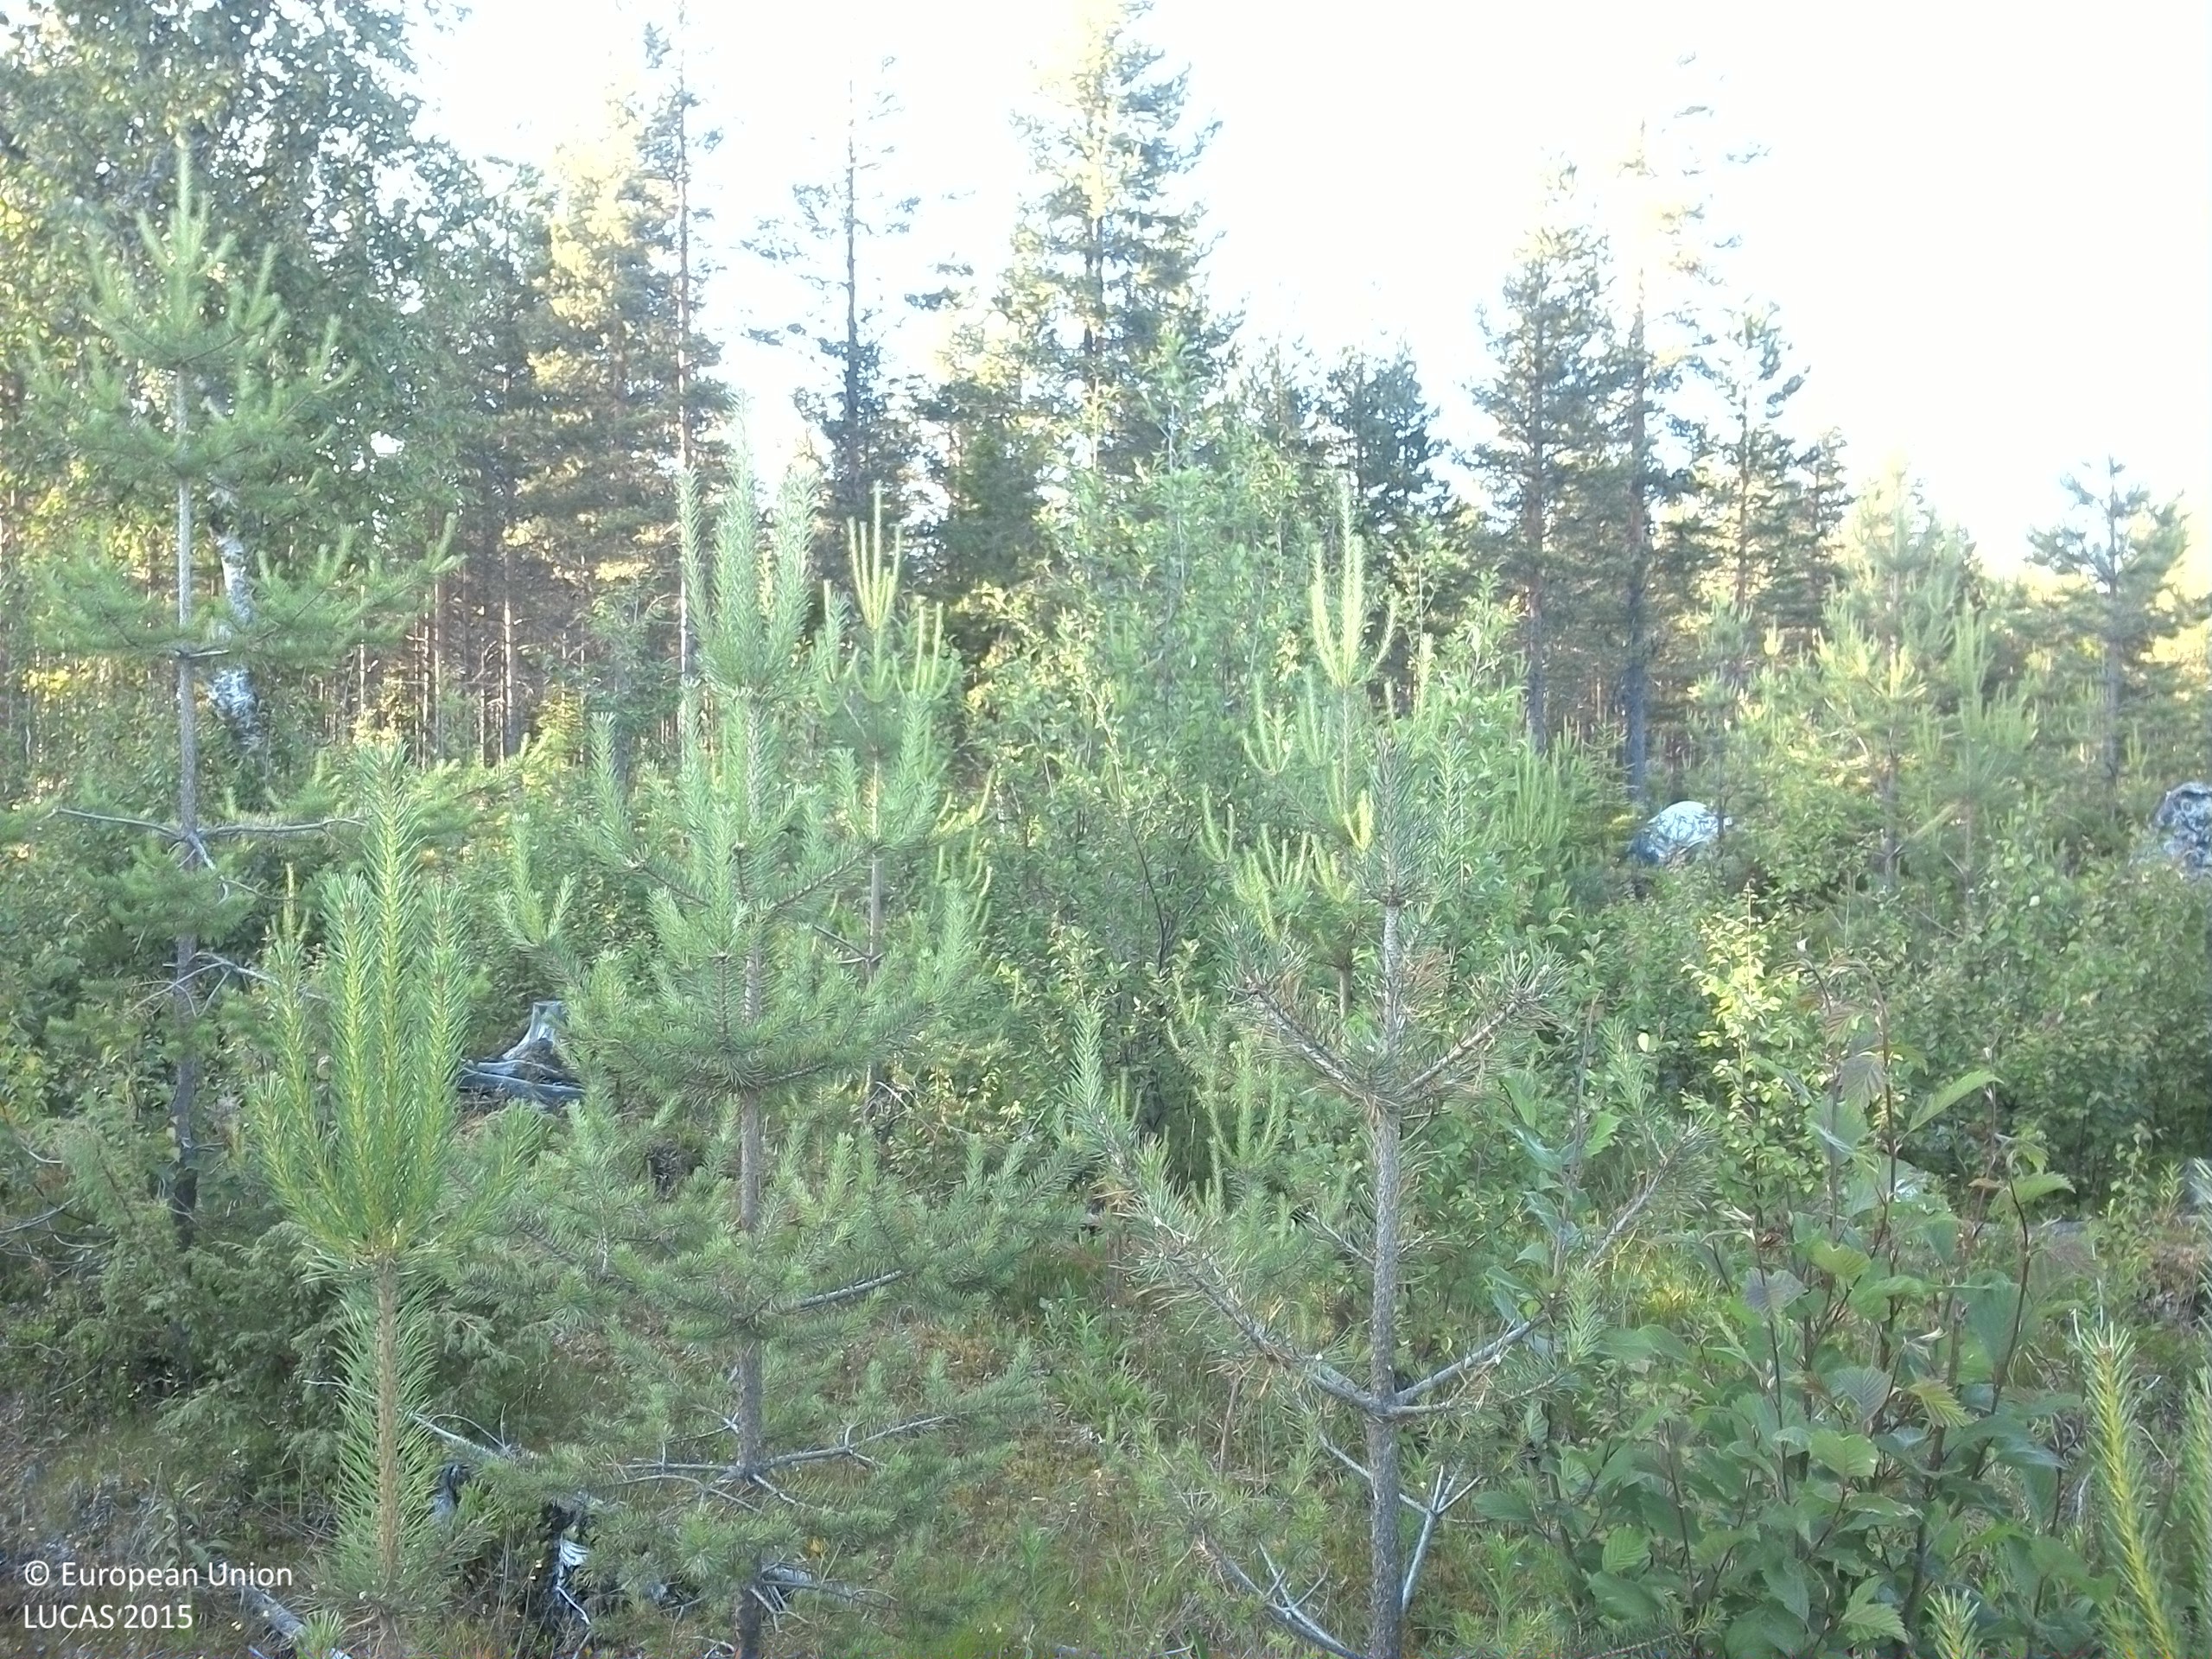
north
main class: Woodland
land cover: Pine dominated mixed woodland
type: boreal forest
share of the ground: 50 - 75 %
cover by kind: coniferous forest trees 45 %, herbaceous plants 20 %, broadleaved forest trees 15 %, shrubs 10 %, lichens and mosses 10 %
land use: Forestry
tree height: < 5 m
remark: Clear cut
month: July
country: SE
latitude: 63.6560
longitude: 17.5472
